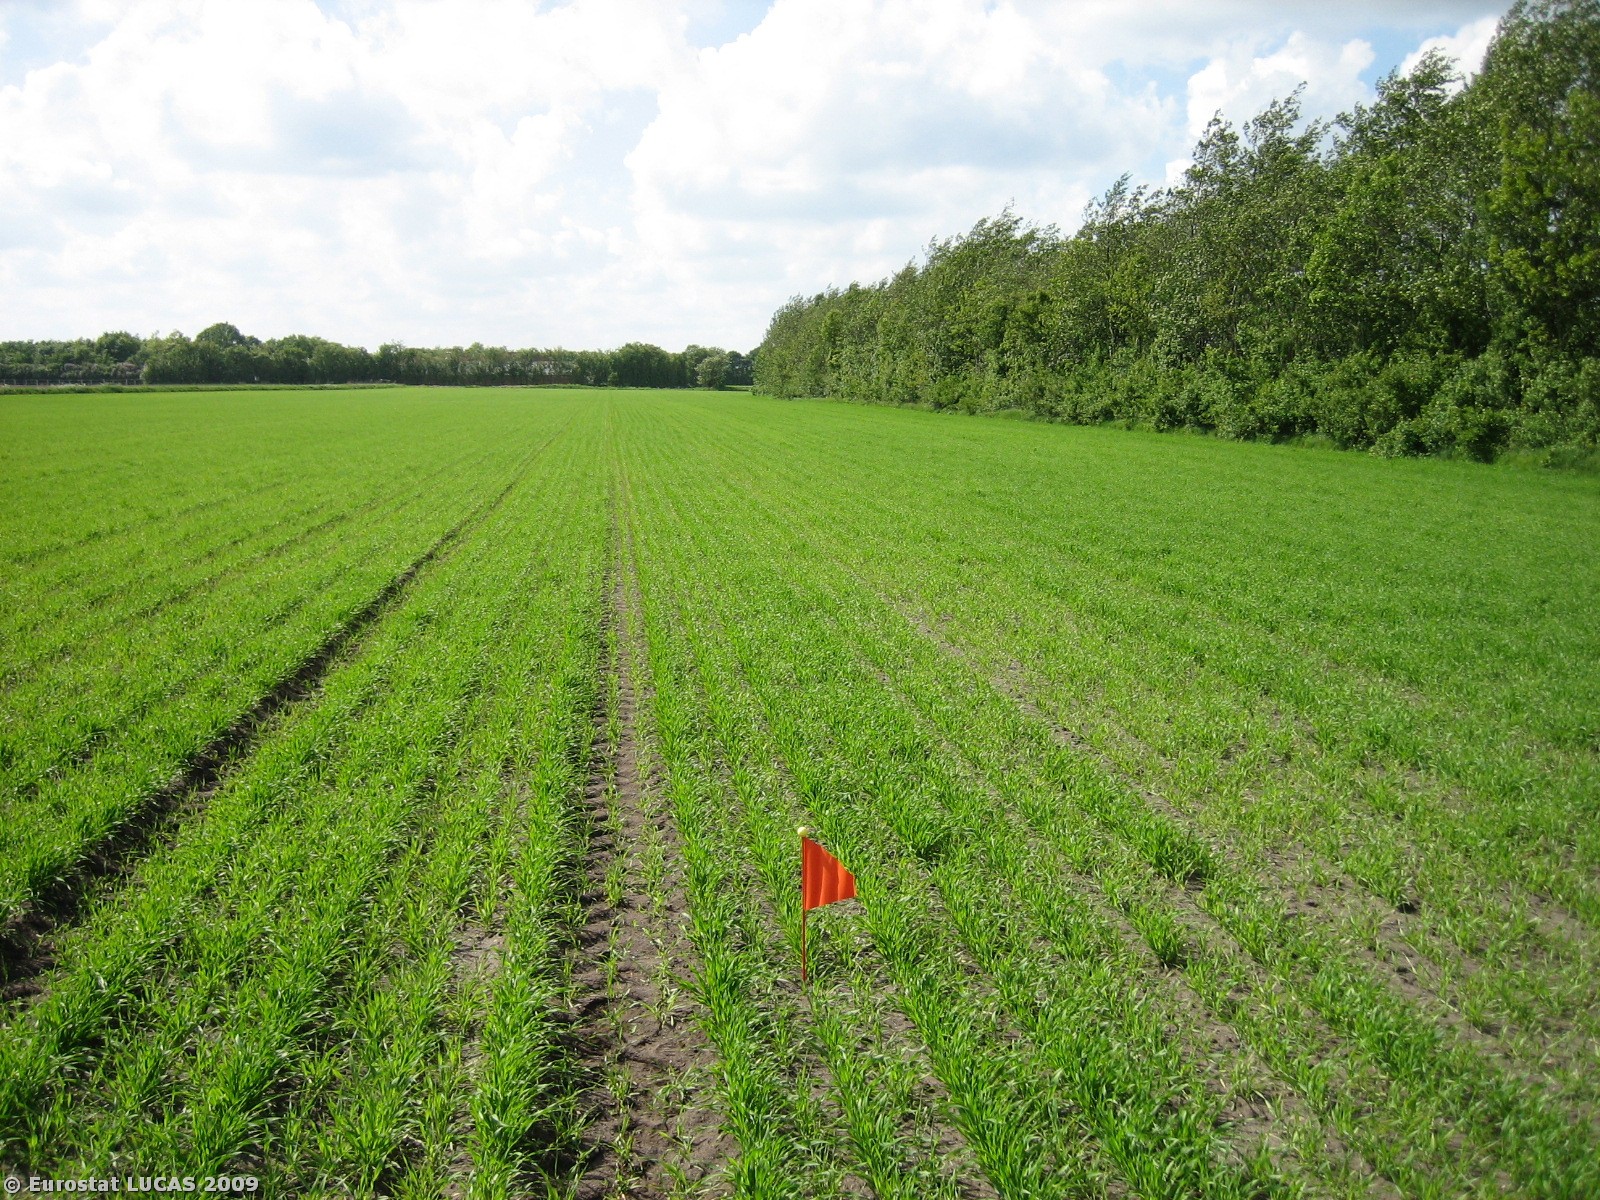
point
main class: Cropland
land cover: Barley
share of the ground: 50 - 75 %
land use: Agriculture (excluding fallow land and kitchen gardens)
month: May
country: DK
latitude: 56.2736
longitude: 8.9838
